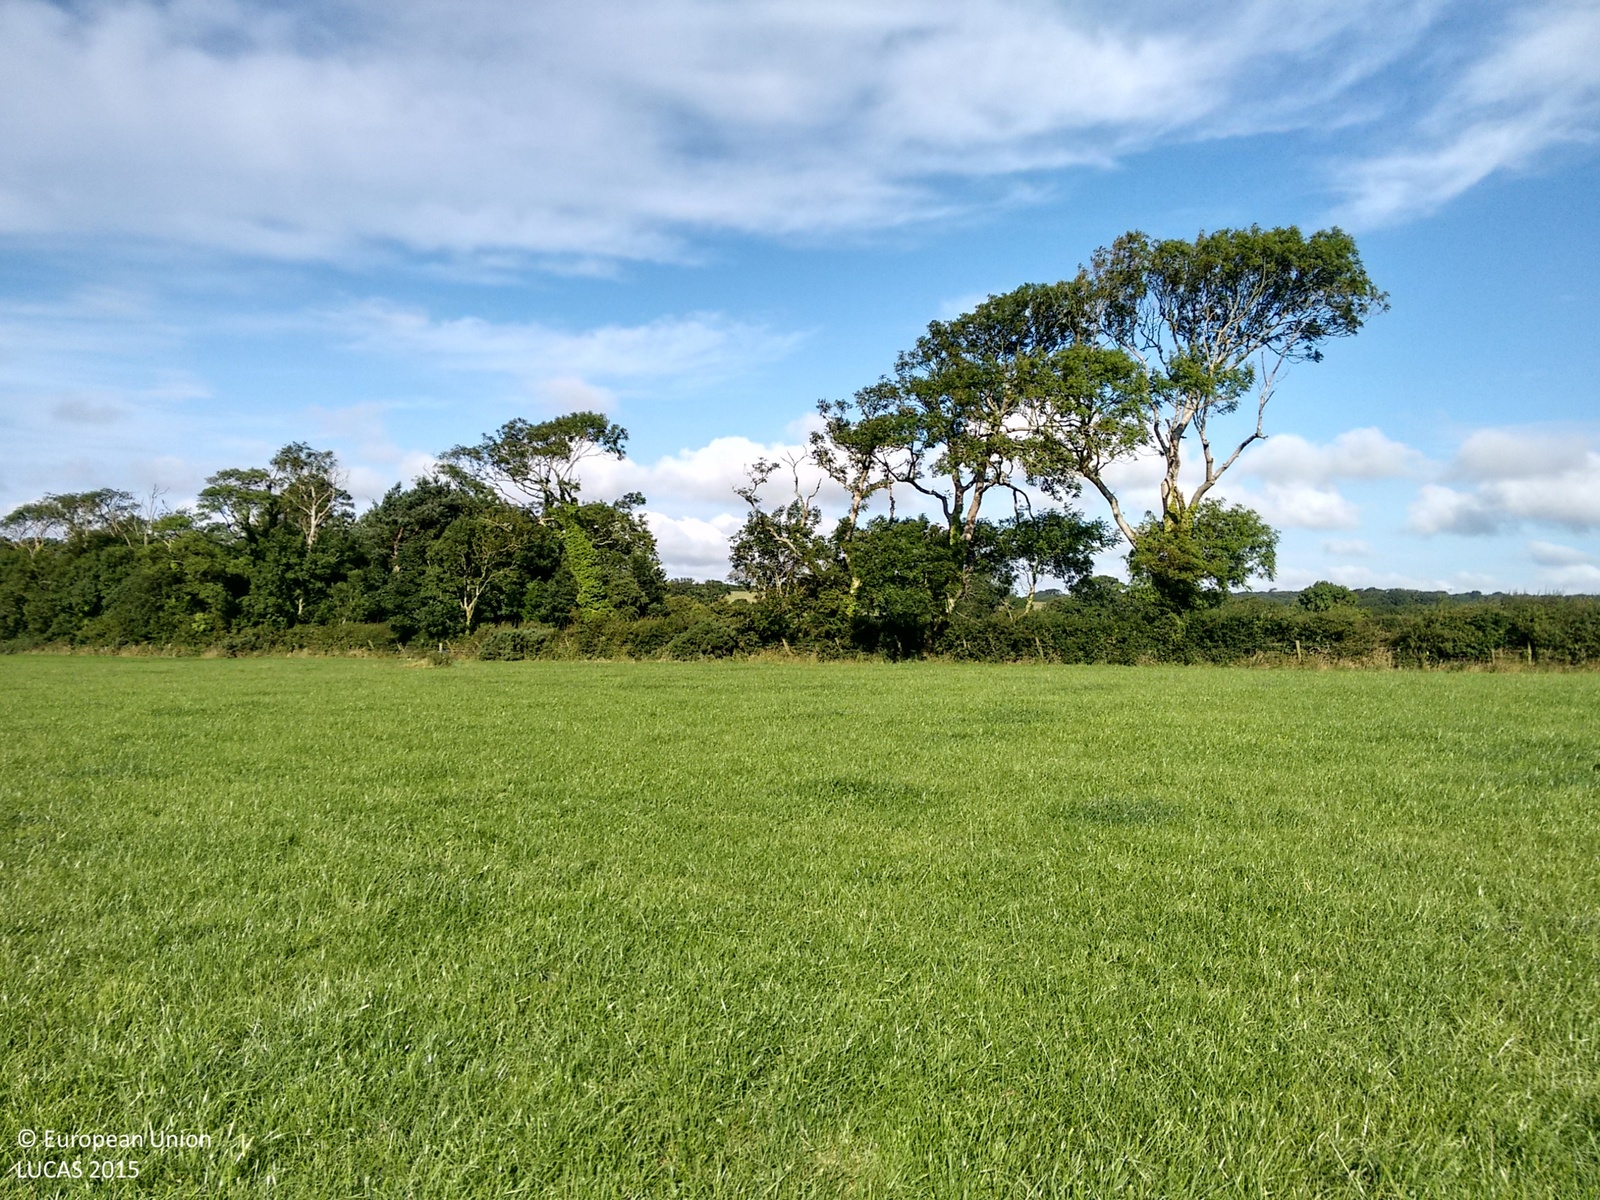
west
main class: Grassland
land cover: Grassland without tree/shrub cover
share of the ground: > 75 %
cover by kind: herbaceous plants 100 %
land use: Agriculture (excluding fallow land and kitchen gardens)
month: August
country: GB
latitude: 53.2955
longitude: -4.3088
